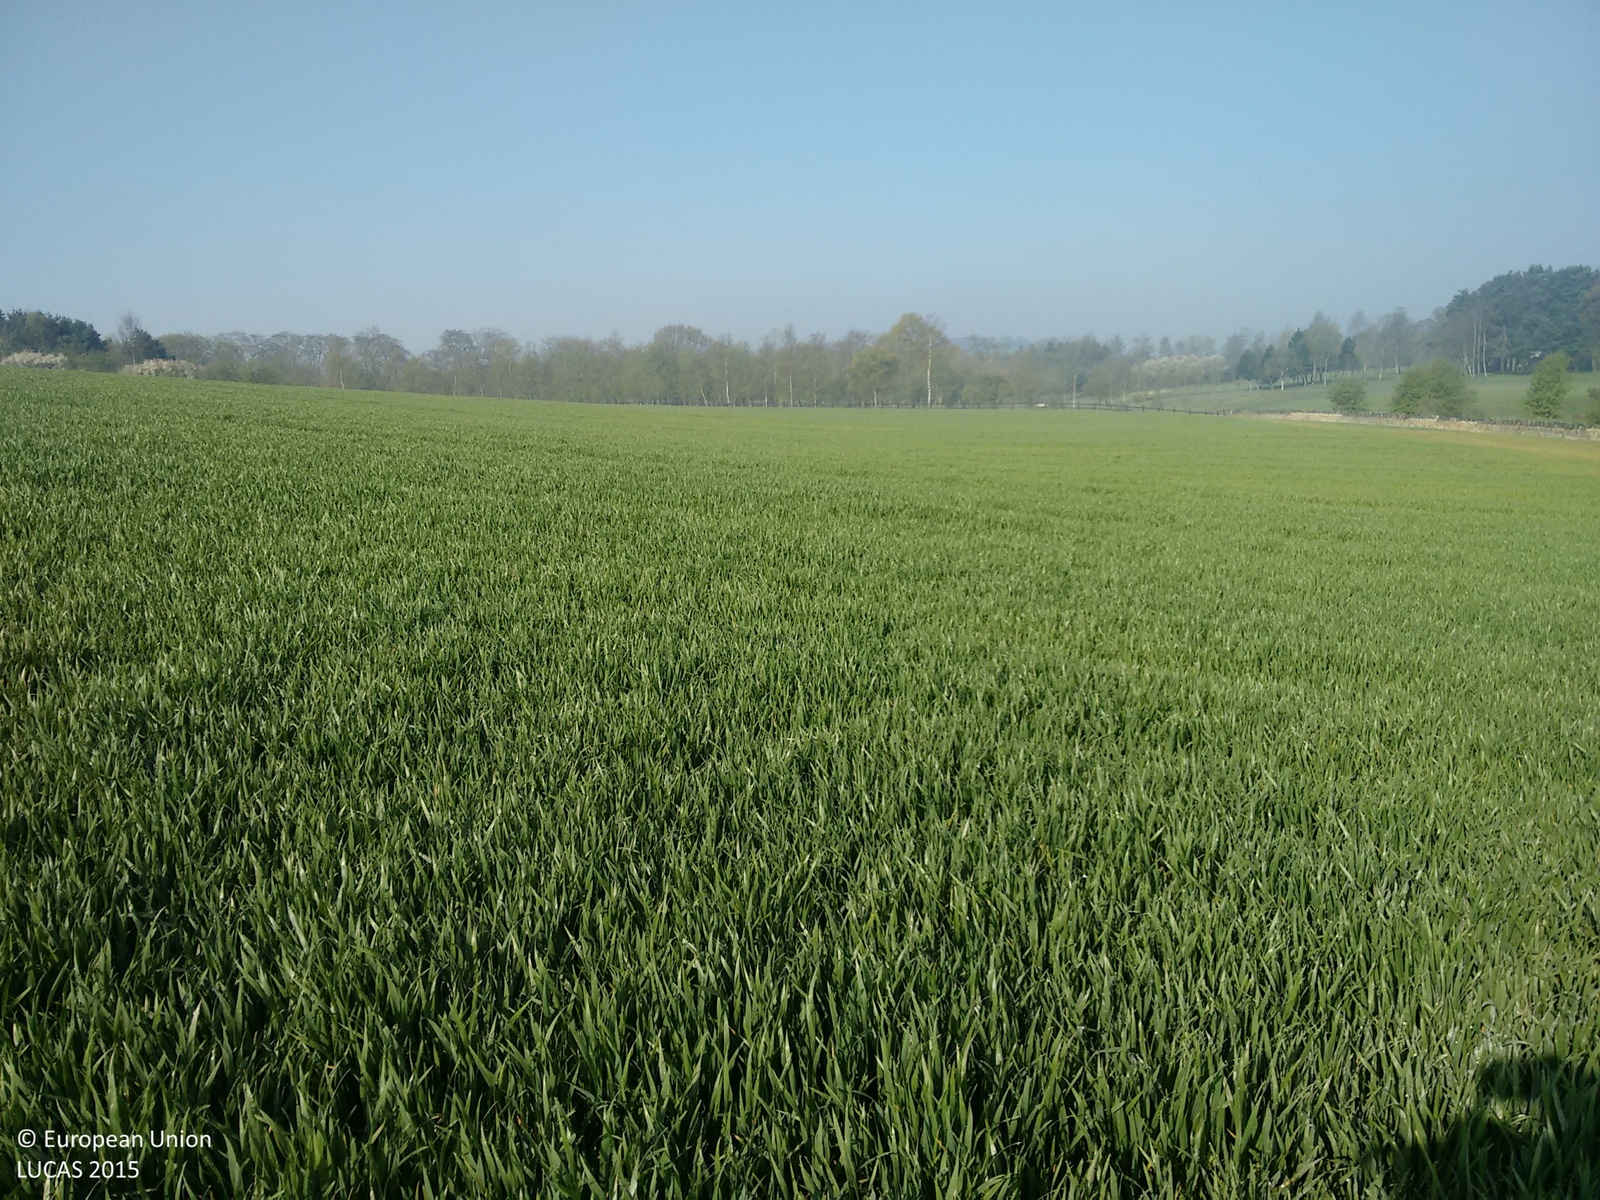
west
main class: Cropland
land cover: Common wheat
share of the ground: > 75 %
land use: Agriculture (excluding fallow land and kitchen gardens)
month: April
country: GB
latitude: 53.8550
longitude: -1.6515
